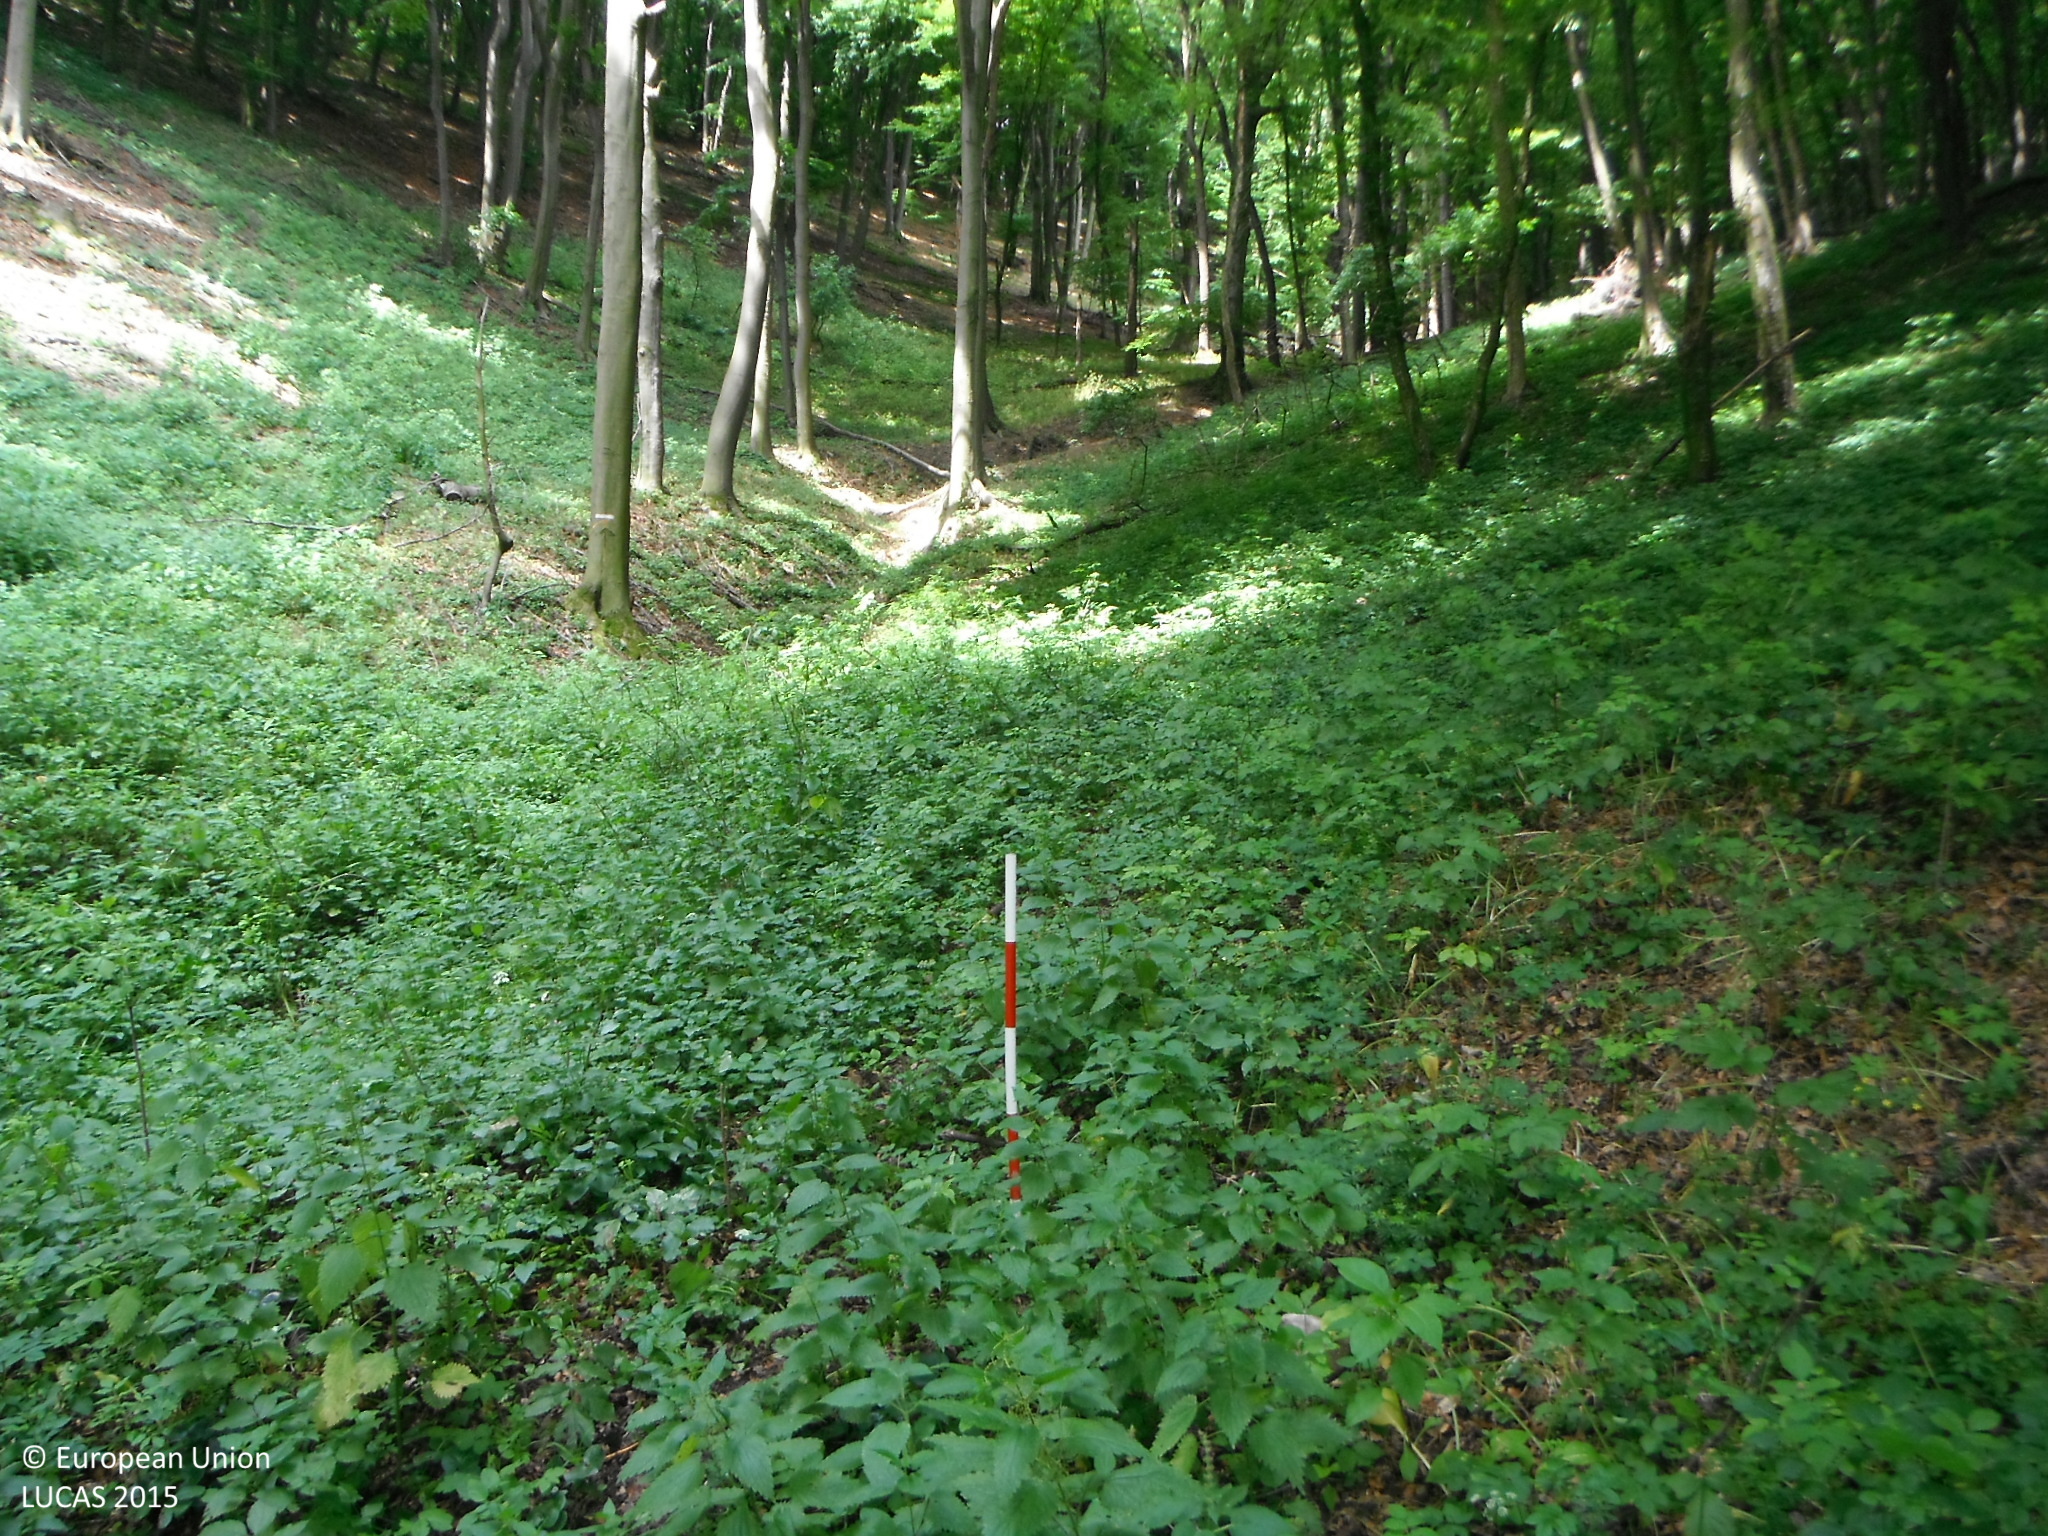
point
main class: Woodland
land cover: Broadleaved woodland
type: mesophytic deciduous forest
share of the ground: > 75 %
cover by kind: broadleaved forest trees 80 %, herbaceous plants 20 %
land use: Forestry
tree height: > 5 m
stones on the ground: < 10 %
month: June
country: SK
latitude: 48.5515
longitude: 17.4208
